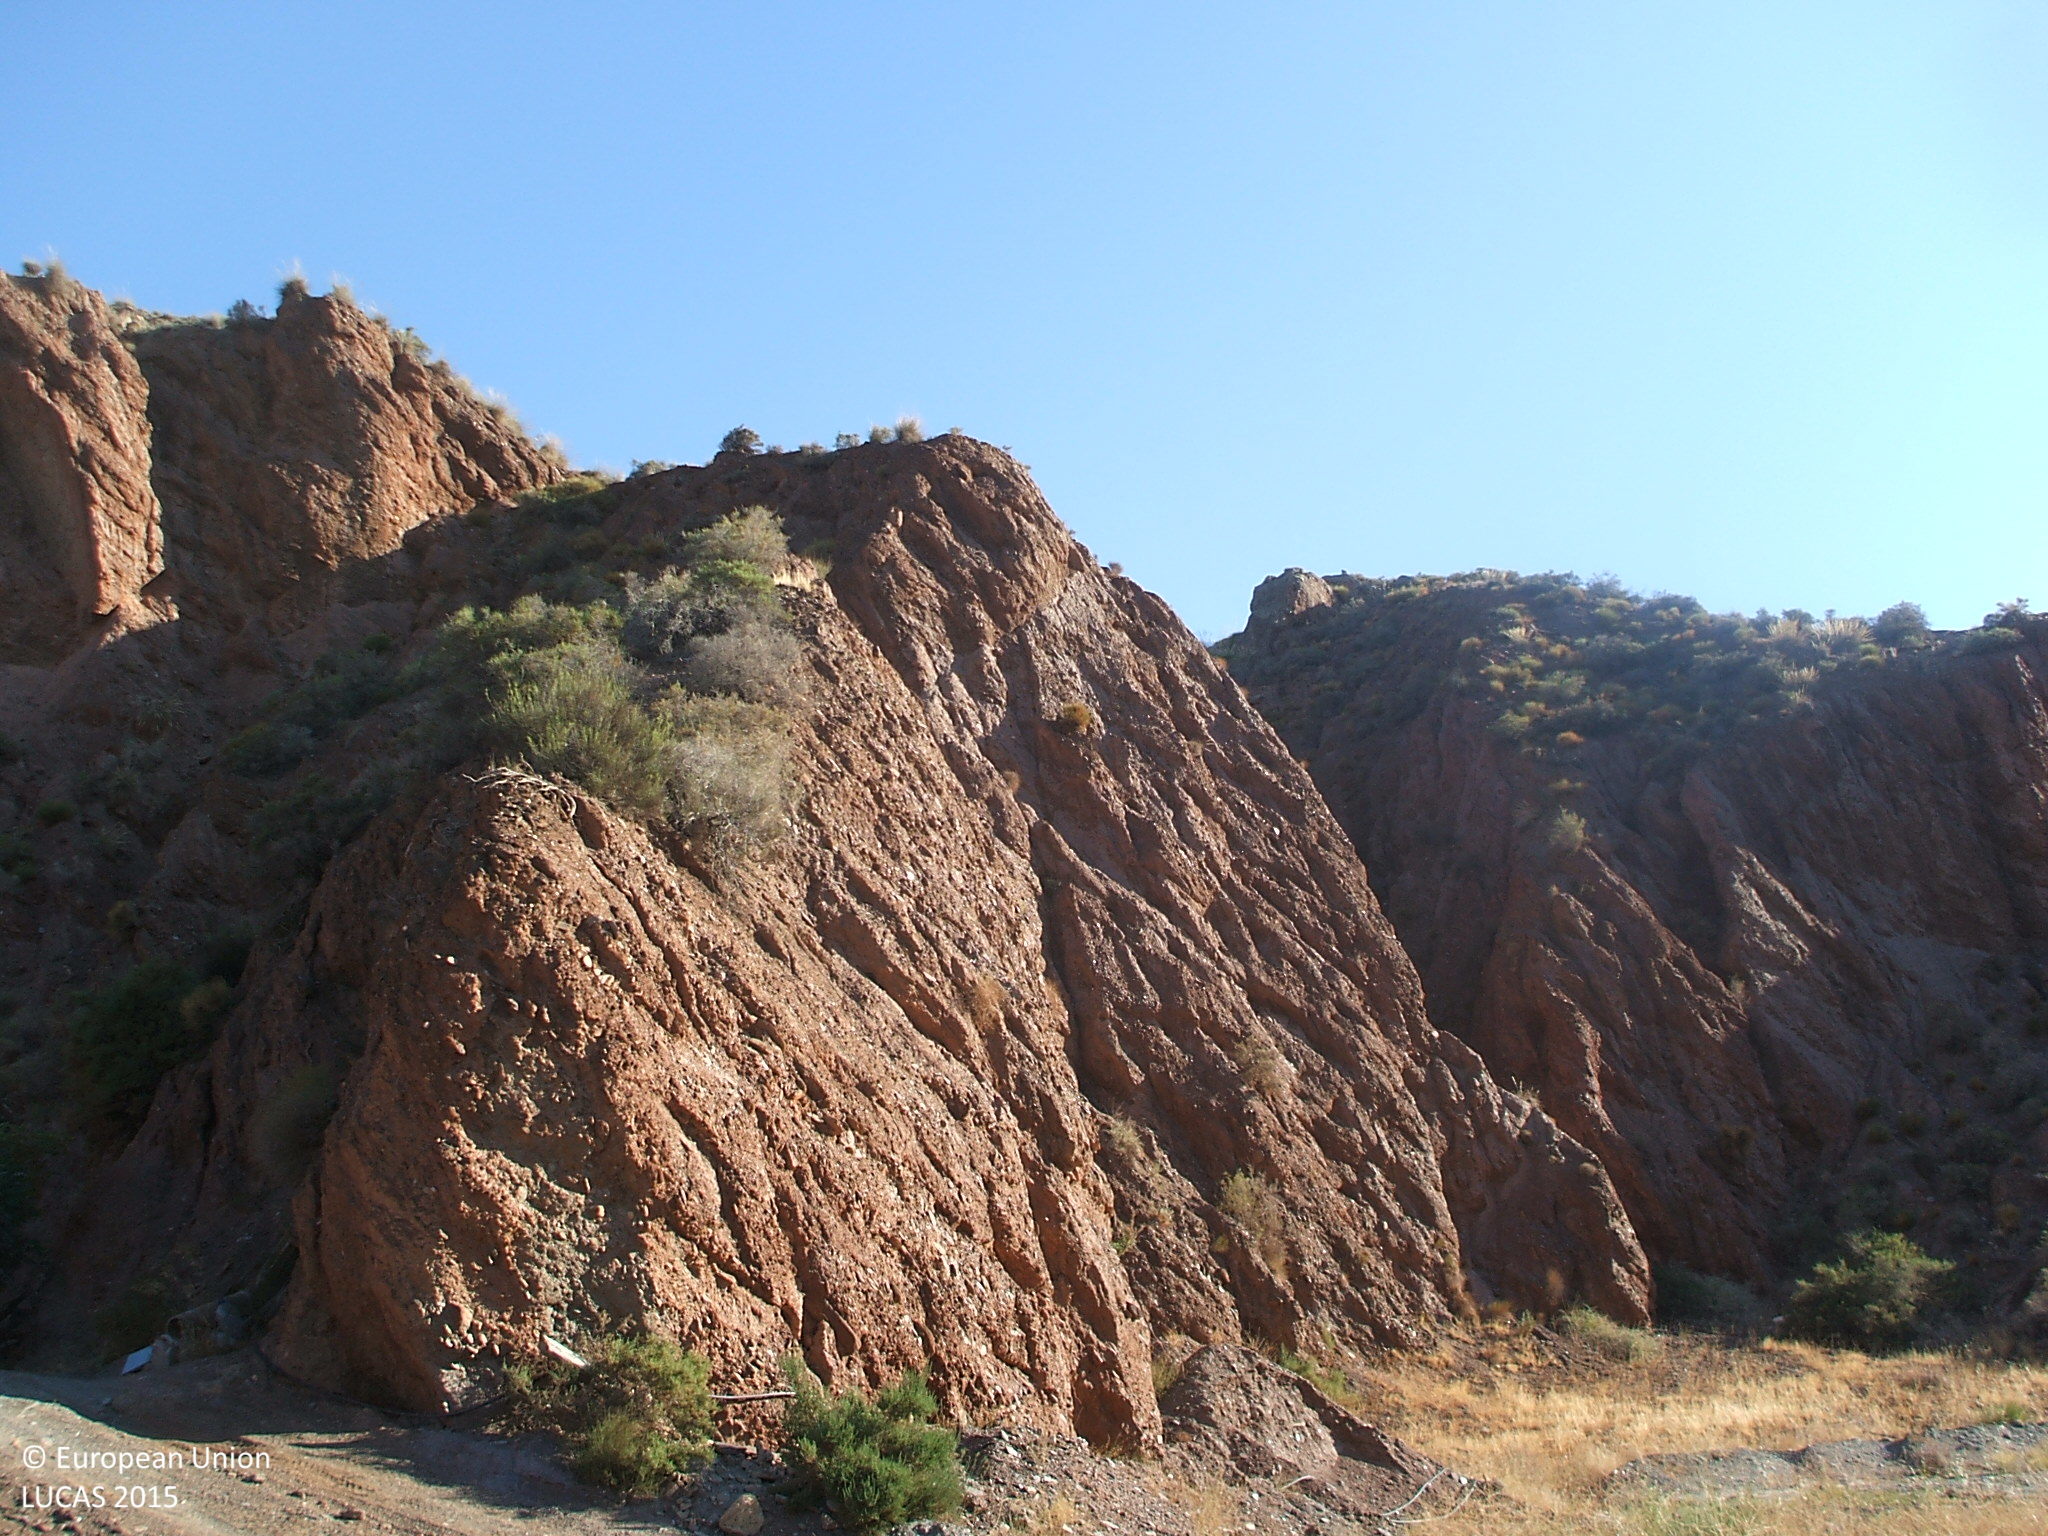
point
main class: Shrubland
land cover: Shrubland without tree cover
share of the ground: 25 - 50 %
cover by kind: consolidated bare surface 70 %, shrubs 30 %
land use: Semi-natural and natural areas not in use
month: June
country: ES
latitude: 37.0337
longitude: -2.6037
